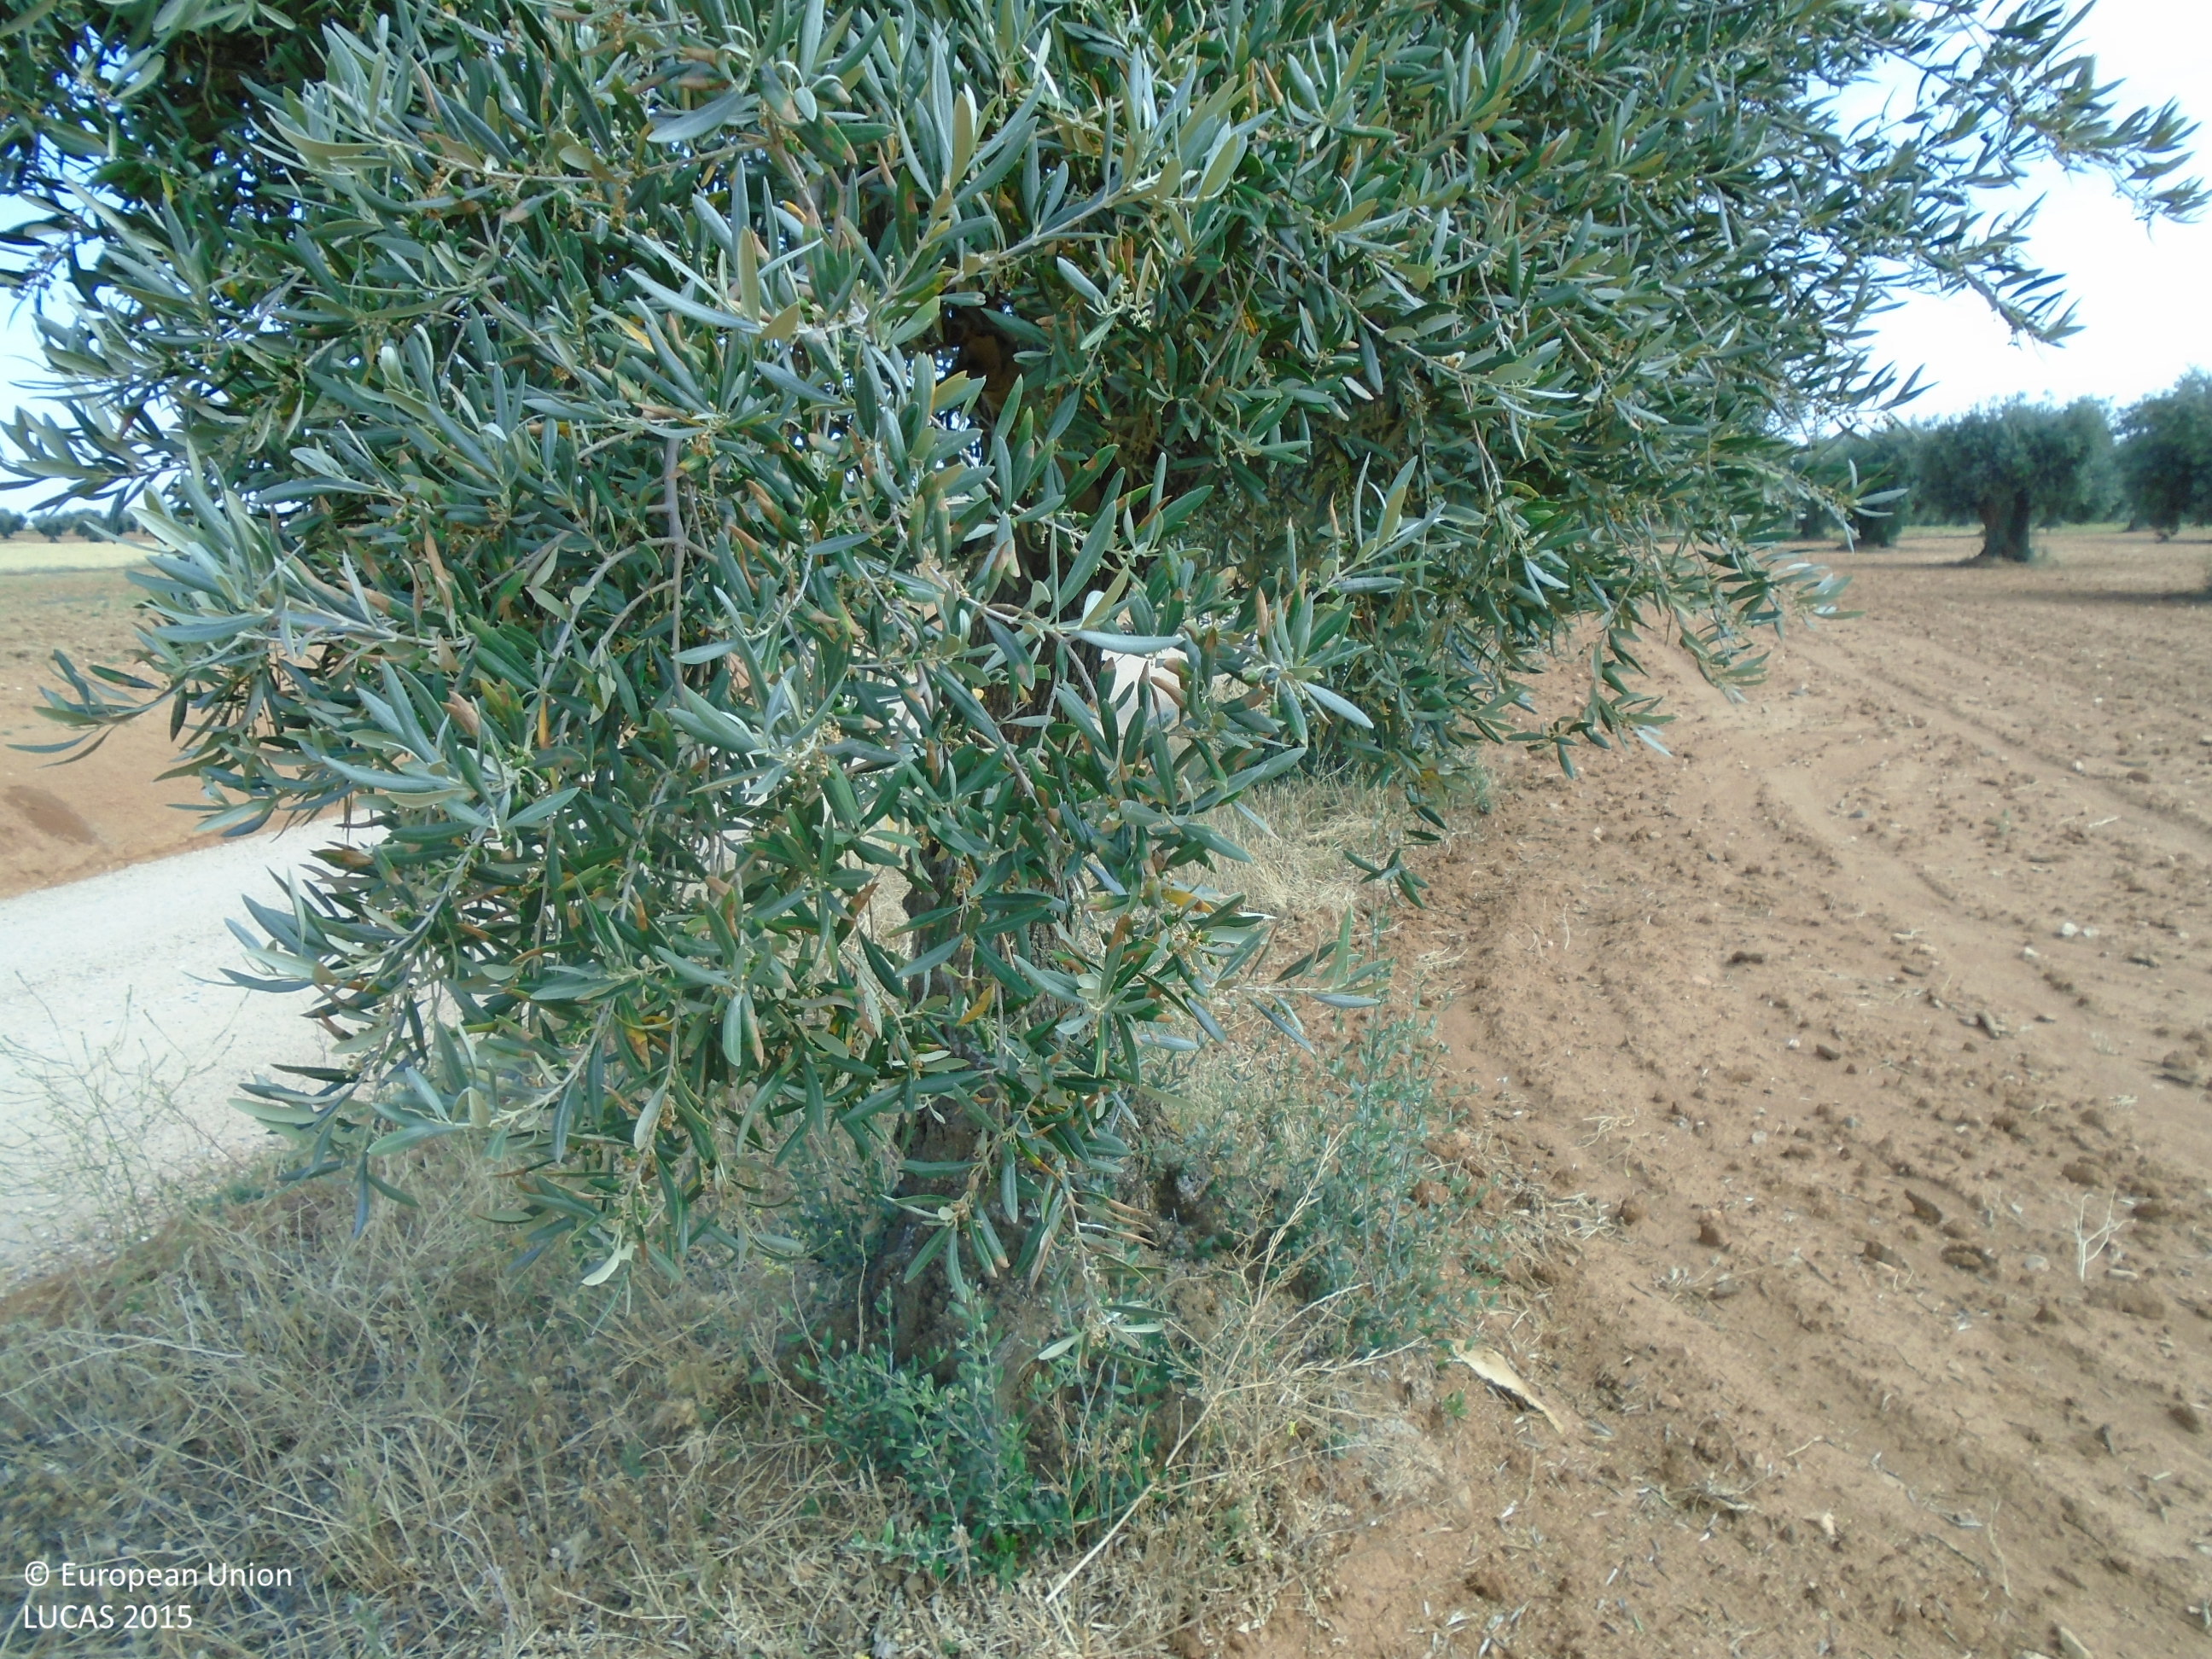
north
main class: Cropland
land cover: Olive groves
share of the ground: 10 - 25 %
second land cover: Other bare soil
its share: > 75 %
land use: Agriculture (excluding fallow land and kitchen gardens)
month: June
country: ES
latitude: 39.7647
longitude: -4.1714
